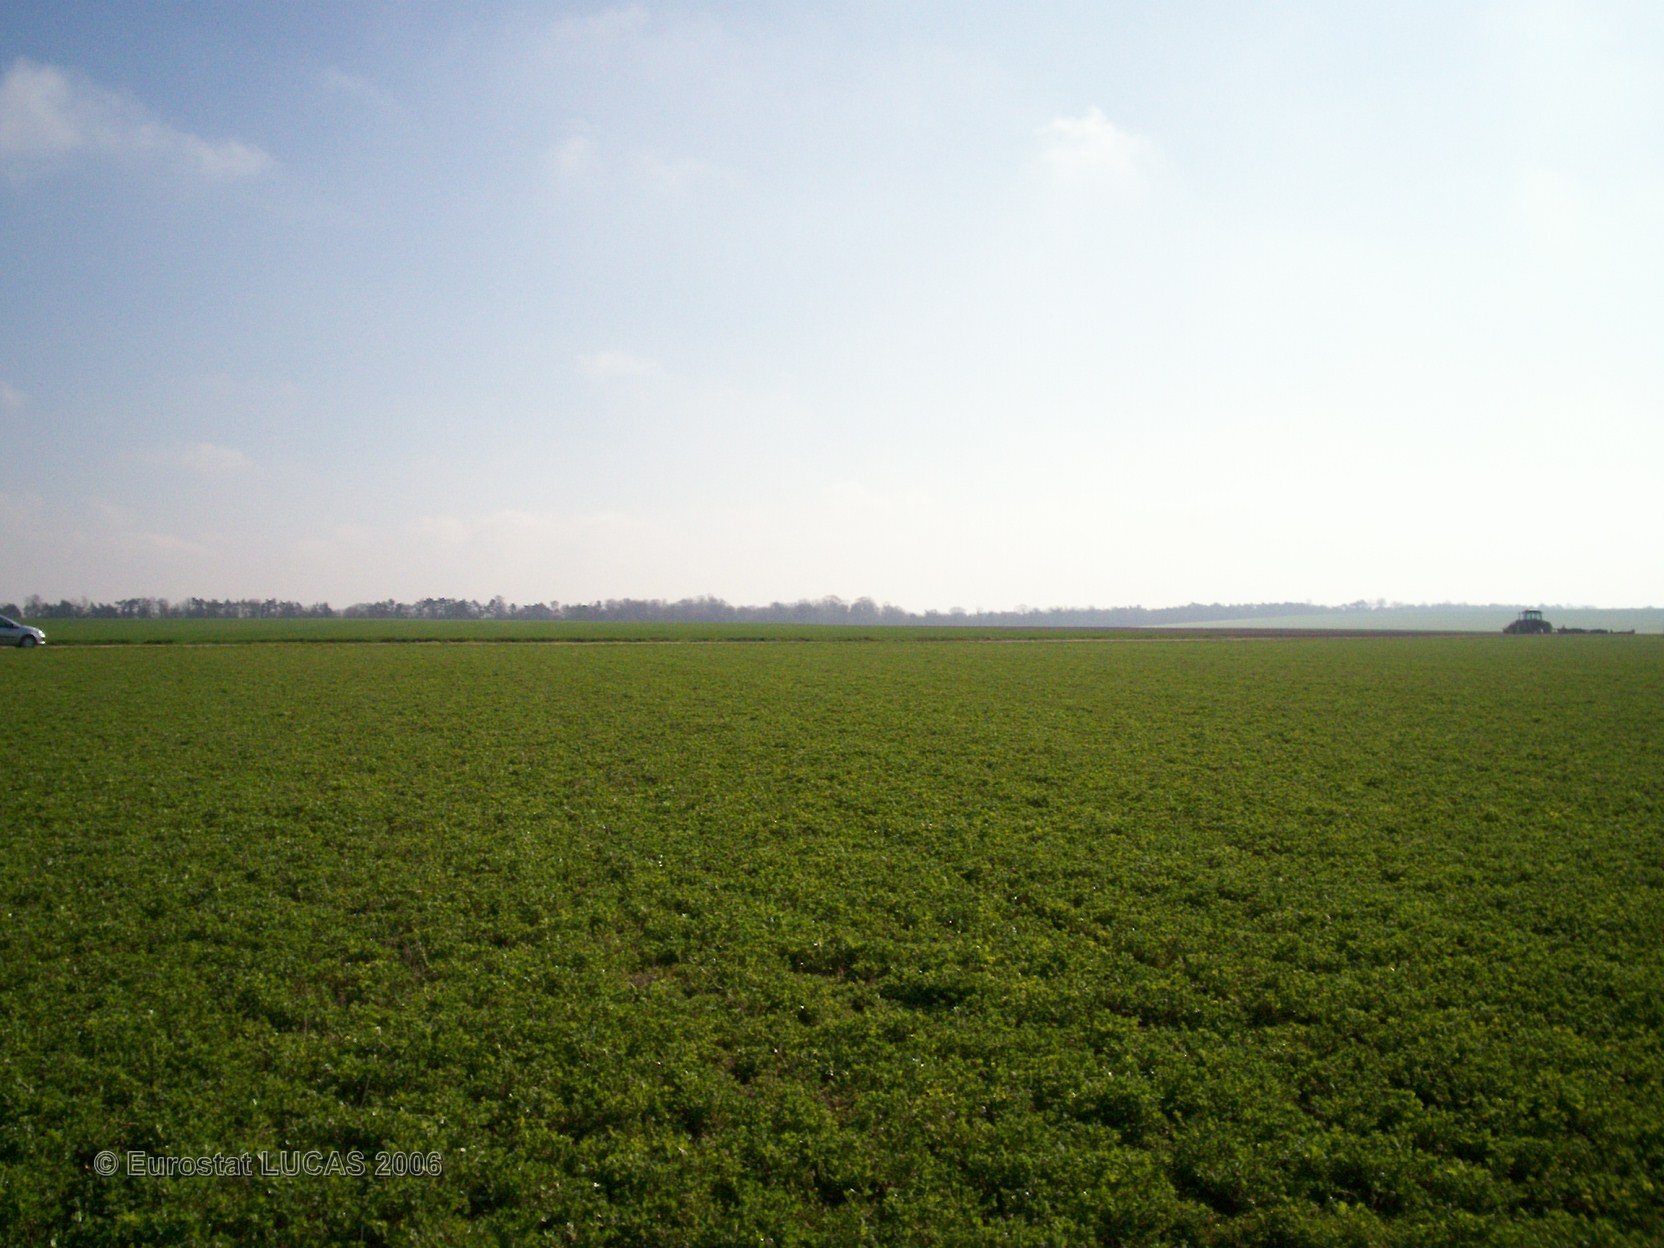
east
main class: Cropland
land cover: Lucerne
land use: Agriculture (excluding fallow land and kitchen gardens)
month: April
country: FR
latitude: 49.0896
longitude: 4.3682
